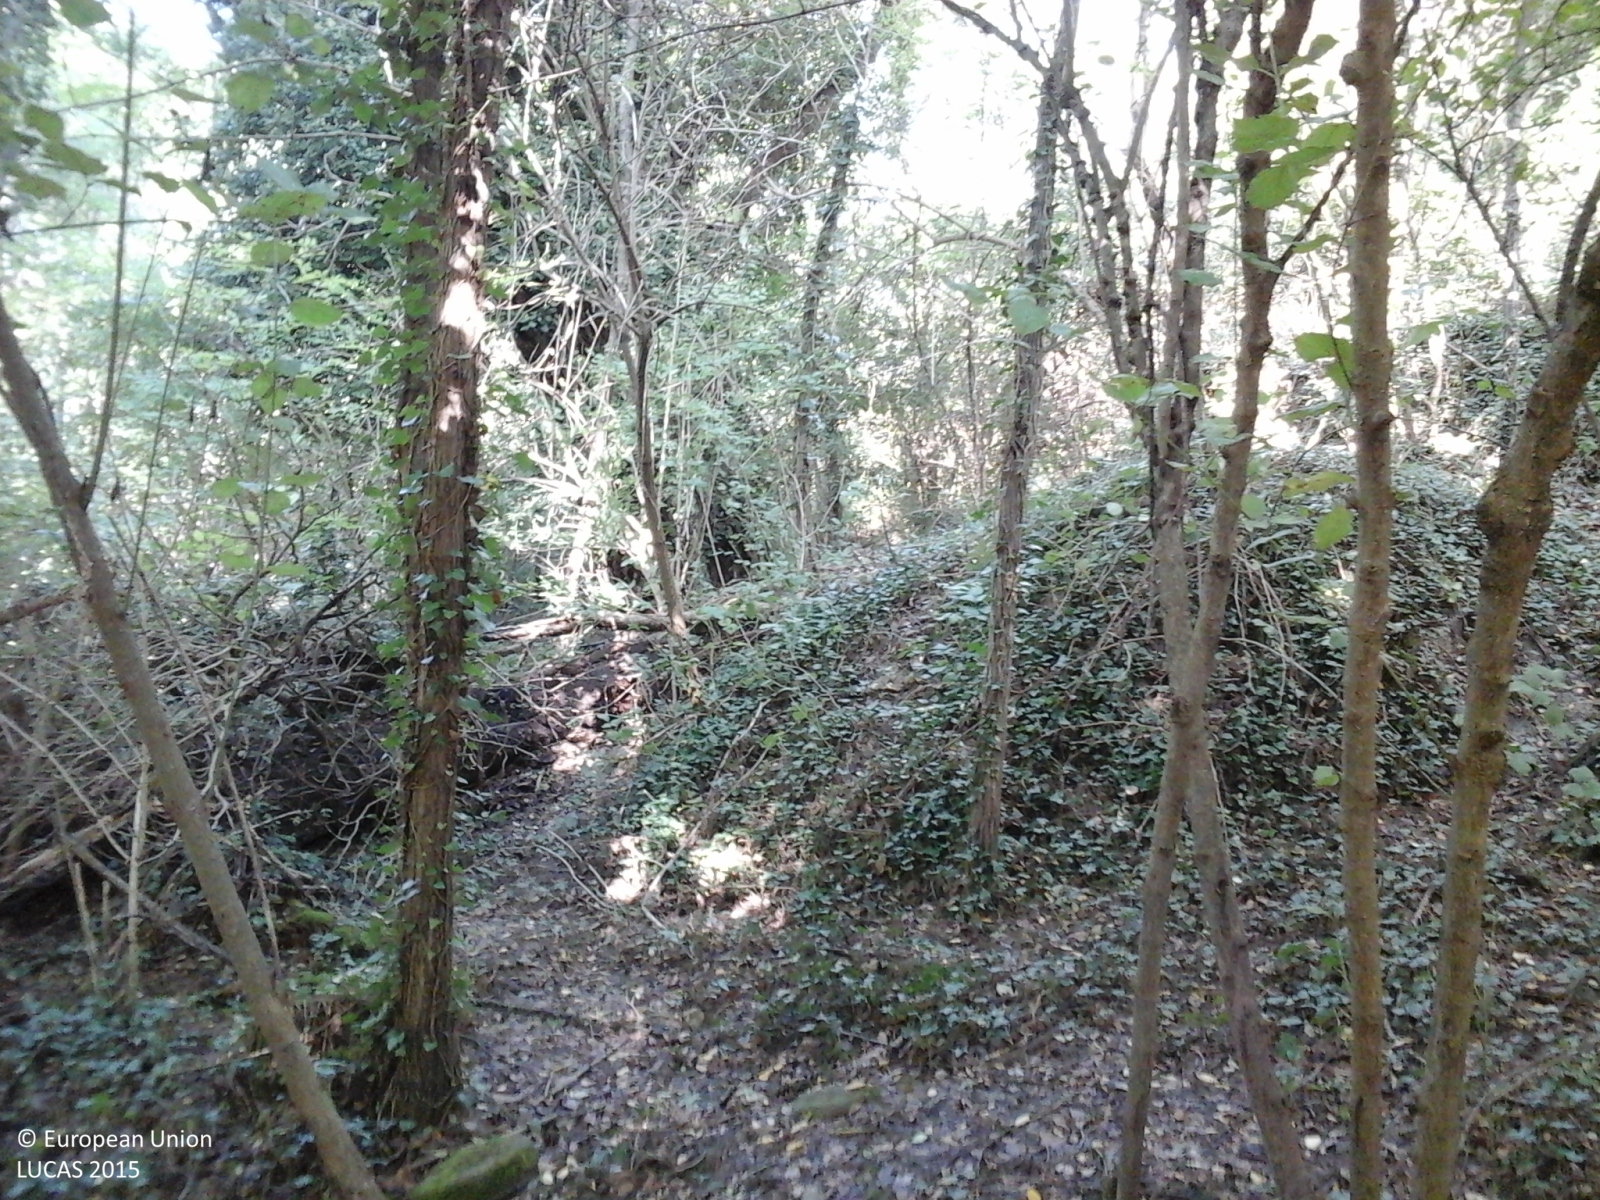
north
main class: Woodland
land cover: Broadleaved woodland
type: thermophilous deciduous forest
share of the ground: > 75 %
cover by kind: broadleaved forest trees 100 %
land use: Semi-natural and natural areas not in use
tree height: > 5 m
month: October
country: IT
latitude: 43.5122
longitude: 13.0230
